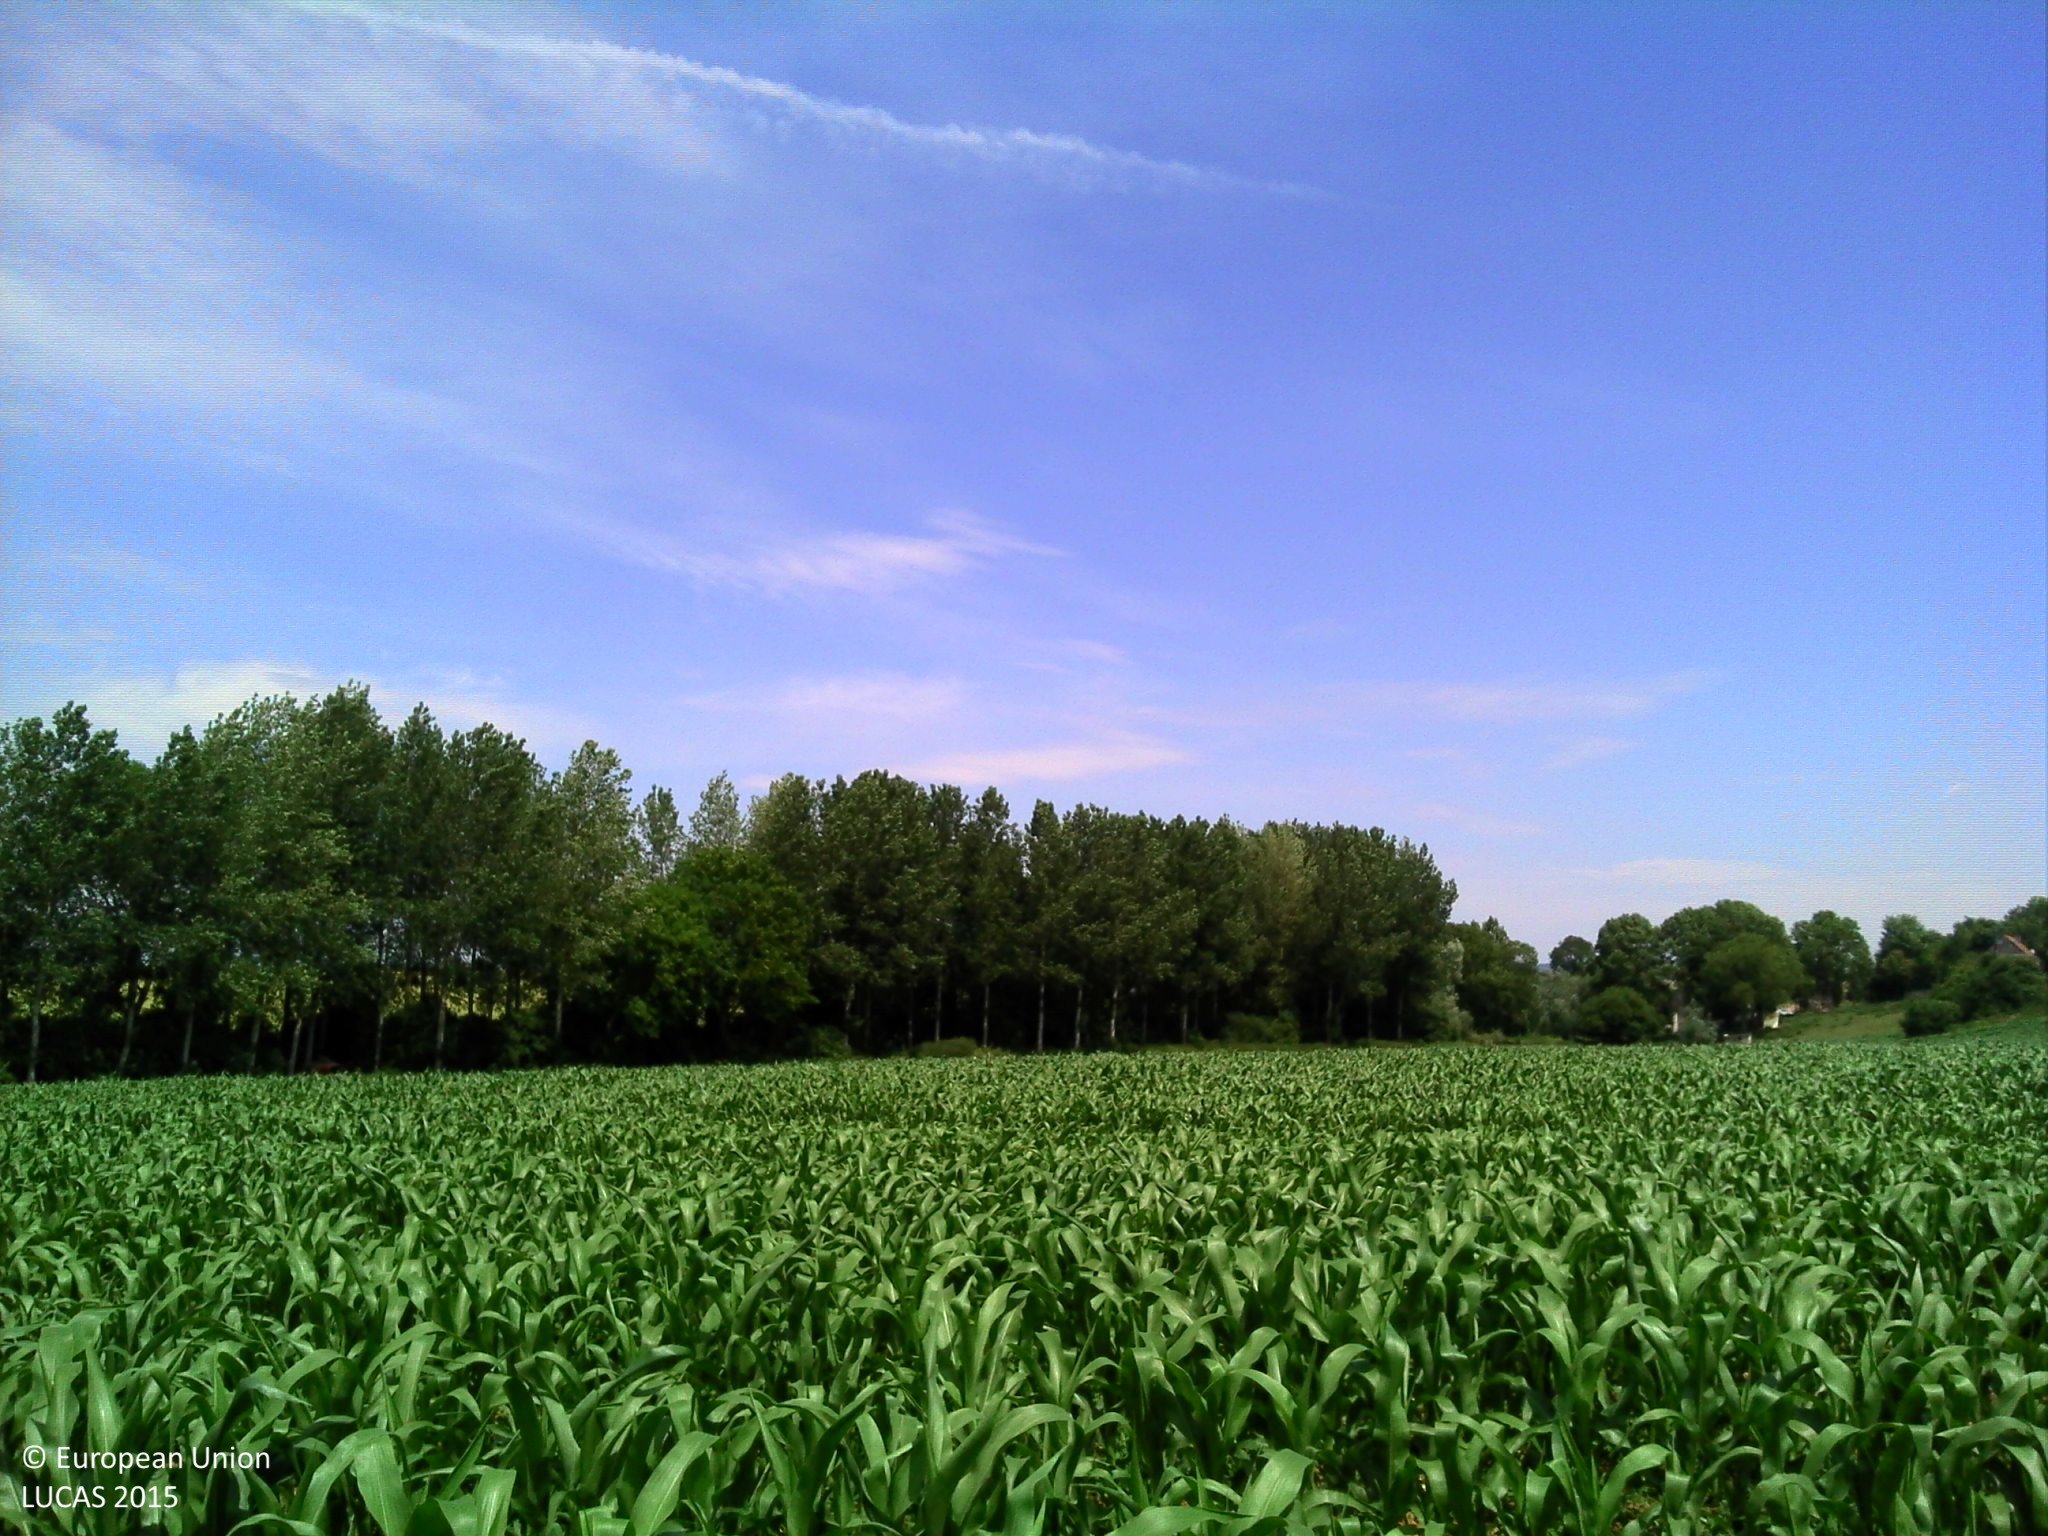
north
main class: Cropland
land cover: Maize
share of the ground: > 75 %
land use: Agriculture (excluding fallow land and kitchen gardens)
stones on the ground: 10 - 25 %
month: June
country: FR
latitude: 48.3160
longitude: 0.2507
